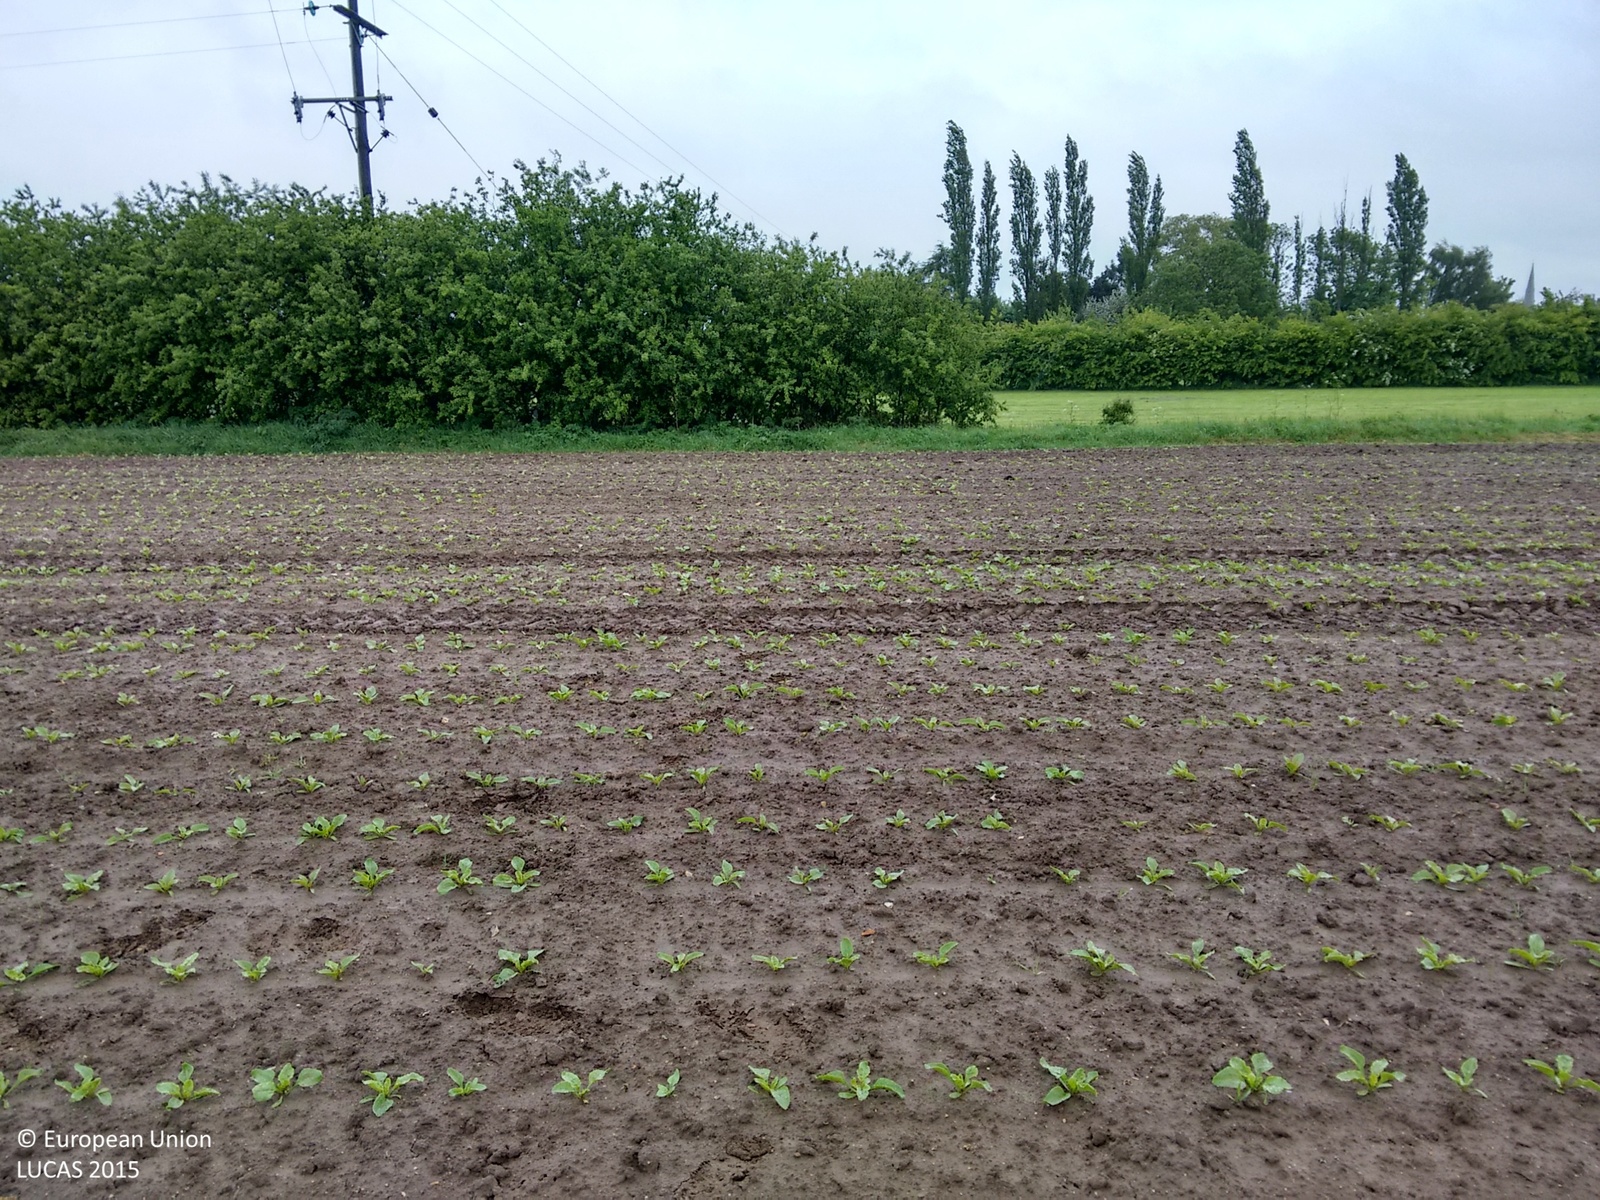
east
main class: Cropland
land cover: Sugar beet
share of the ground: < 10 %
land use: Agriculture (excluding fallow land and kitchen gardens)
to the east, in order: Sugar beet; Grass margins; Ditches and canals; Managed hedges; Grassland without tree/shrub cover; Electric lines; Abandoned hedges; Grassland without tree/shrub cover; Managed hedges; Grassland without tree/shrub cover; Managed hedges; Ditches and canals; Grass margins; Artificial constructions in urban areas; Managed hedges; Grass margins; Dry pulses
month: May
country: GB
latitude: 52.9062
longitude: -0.0992
